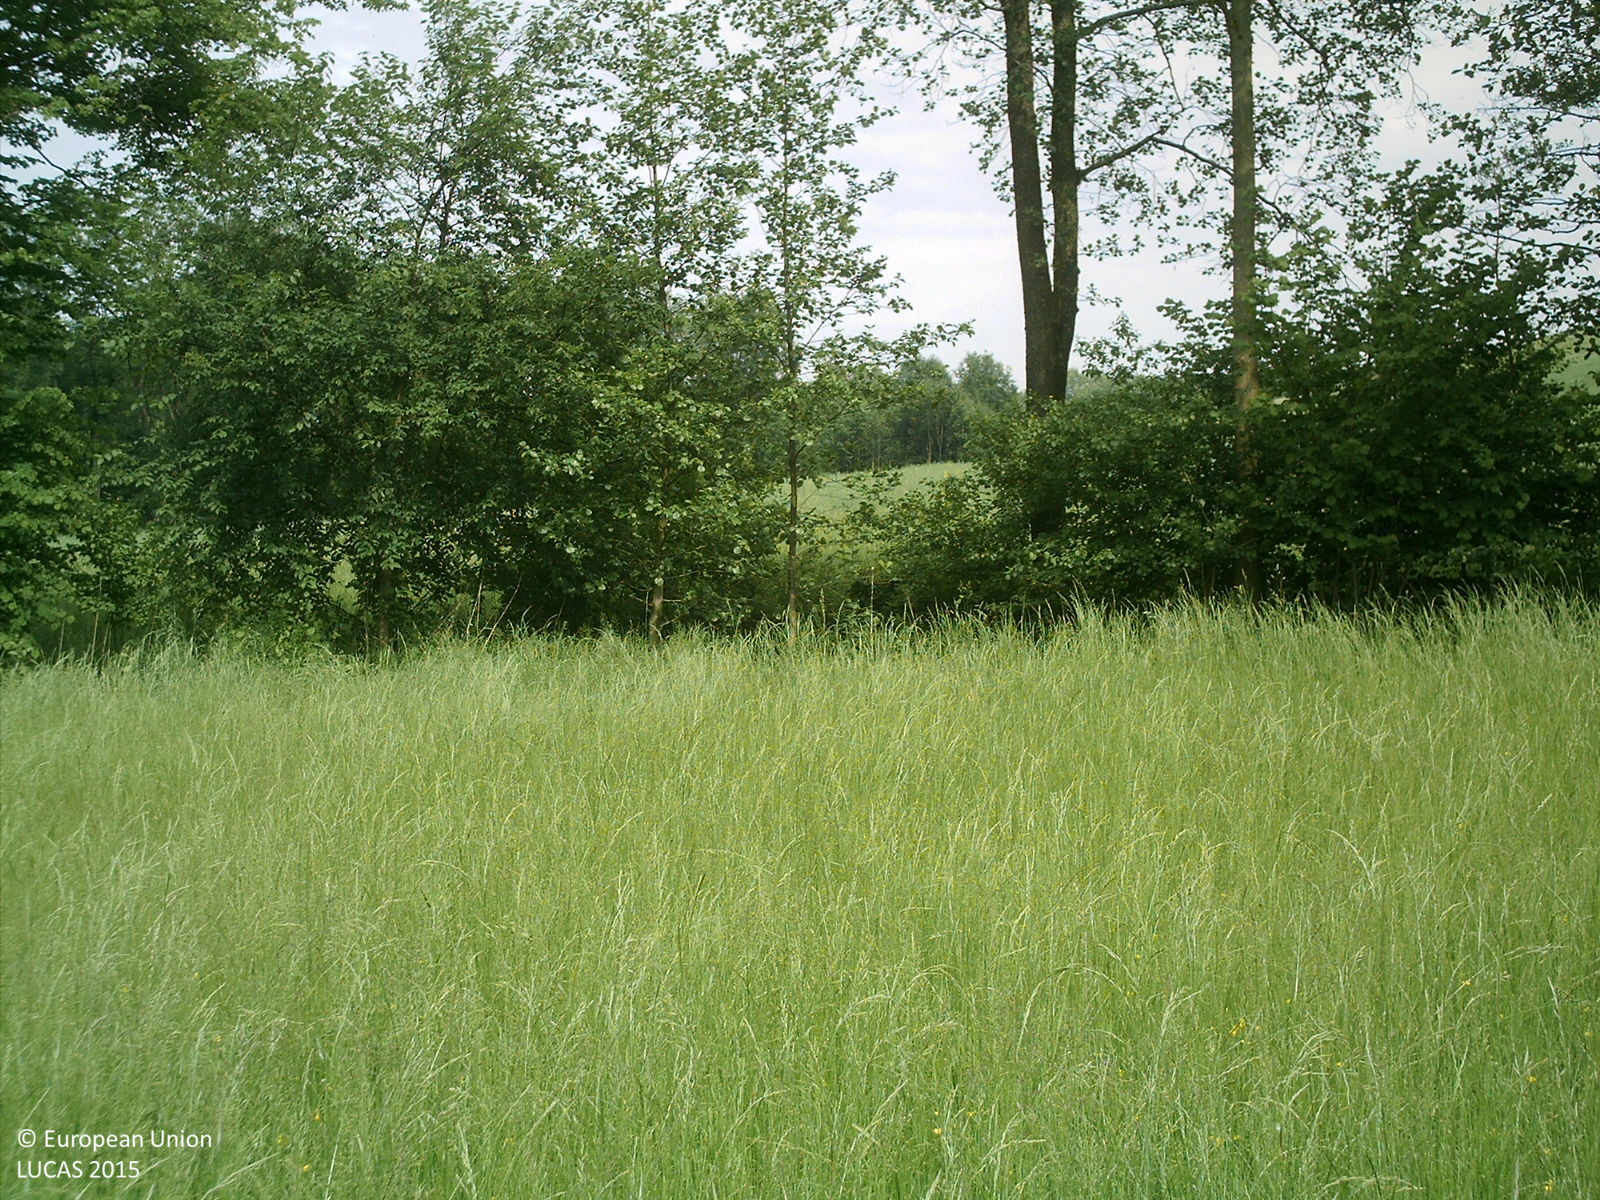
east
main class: Grassland
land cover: Grassland without tree/shrub cover
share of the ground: > 75 %
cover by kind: herbaceous plants 100 %
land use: Agriculture (excluding fallow land and kitchen gardens)
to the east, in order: Grassland without tree/shrub cover; Broadleaved woodland; Rivers and streams; Broadleaved woodland; Grassland without tree/shrub cover; Rape and turnip rape; Grassland without tree/shrub cover; Barley
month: May
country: AT
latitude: 48.1064
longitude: 14.2303
